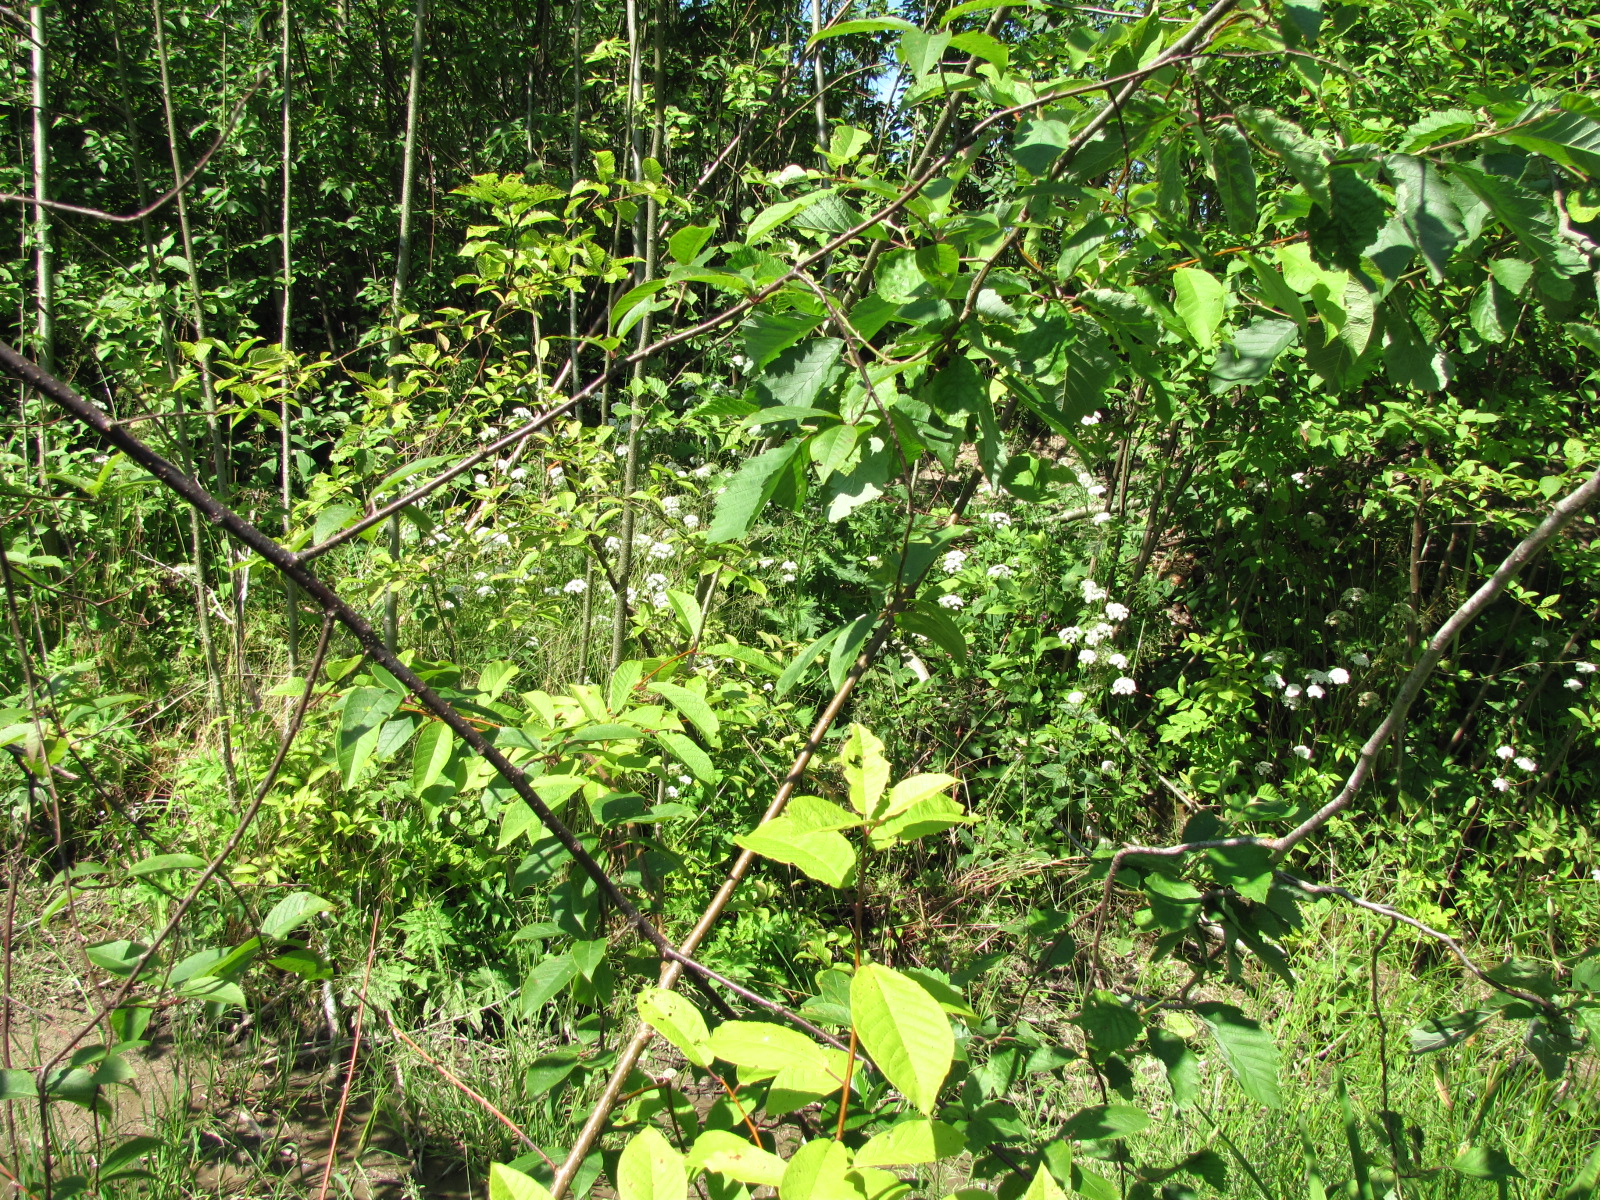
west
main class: Woodland
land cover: Broadleaved woodland
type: non-riverine alder, birch or aspen forest
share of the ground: > 75 %
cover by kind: broadleaved forest trees 100 %
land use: Forestry
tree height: < 5 m
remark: Clear cut
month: June
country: LV
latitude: 56.3595
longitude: 23.8897
